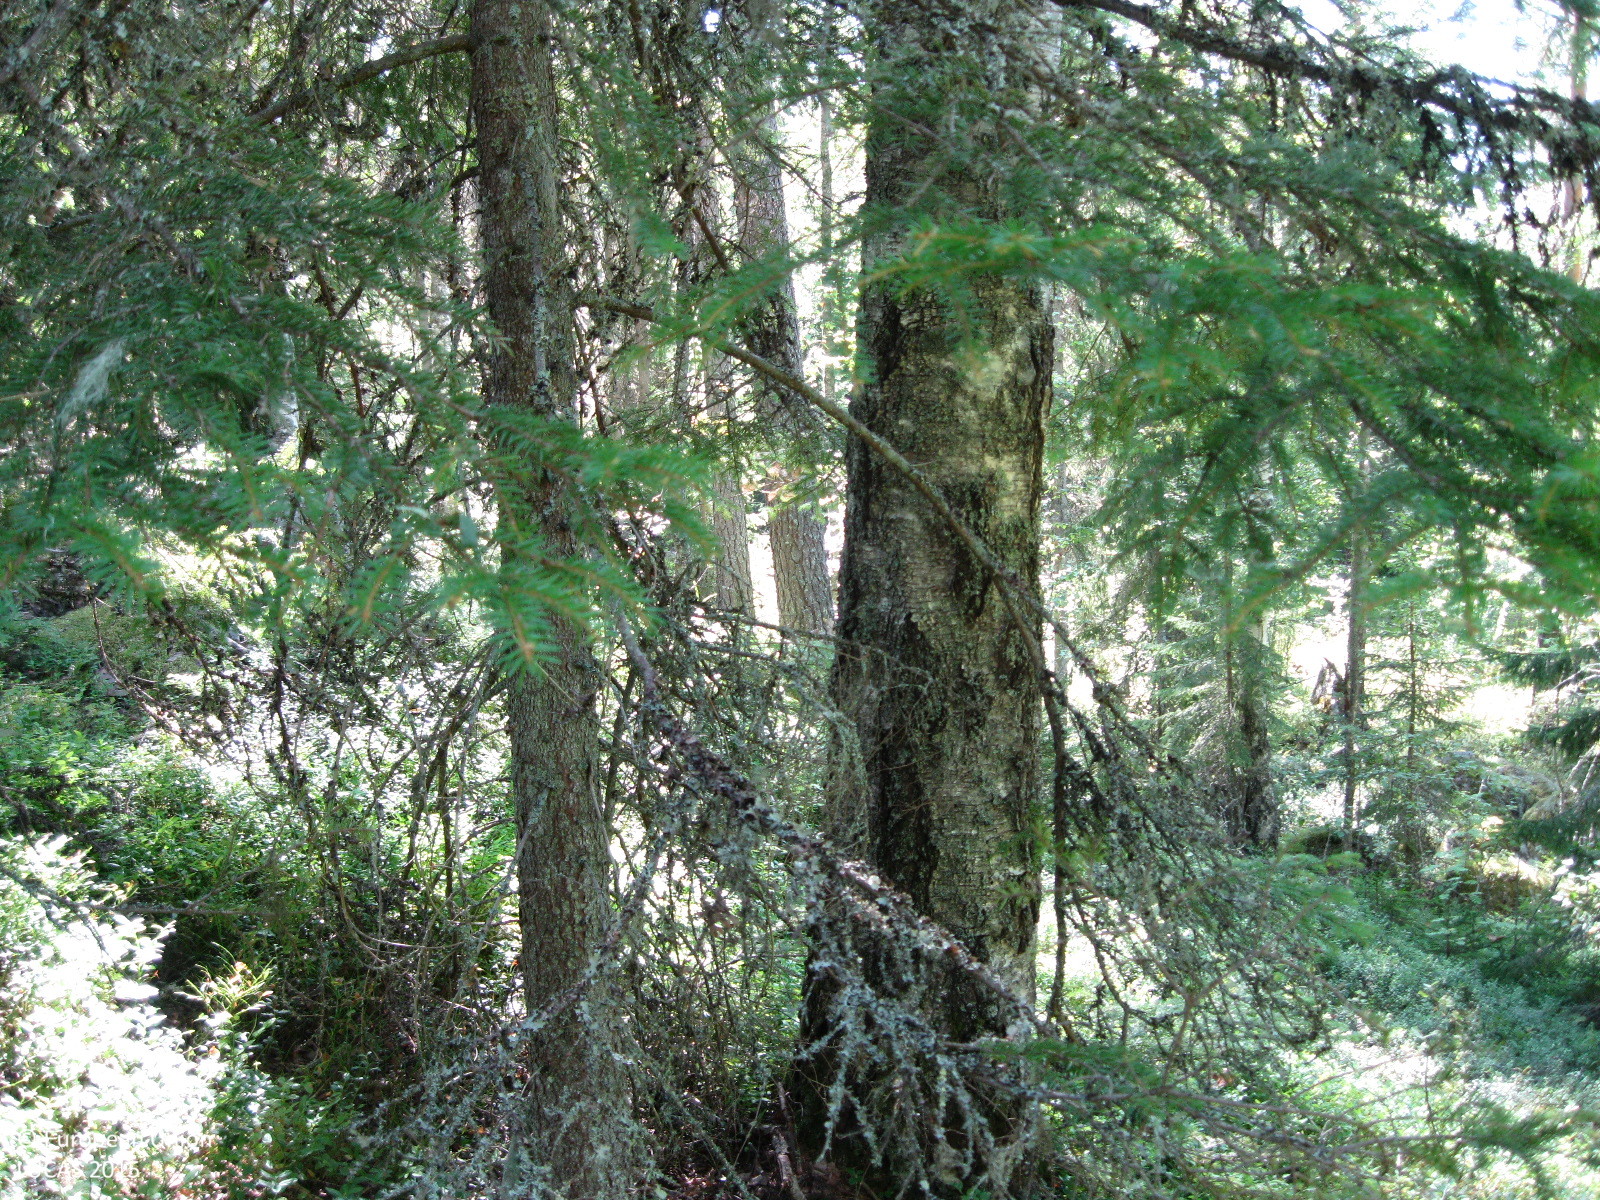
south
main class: Woodland
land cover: Other mixed woodland
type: boreal forest
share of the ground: 25 - 50 %
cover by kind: shrubs 50 %, coniferous forest trees 30 %, broadleaved forest trees 10 %, herbaceous plants 10 %
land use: Forestry
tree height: > 5 m
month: August
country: FI
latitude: 61.3347
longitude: 25.0432
